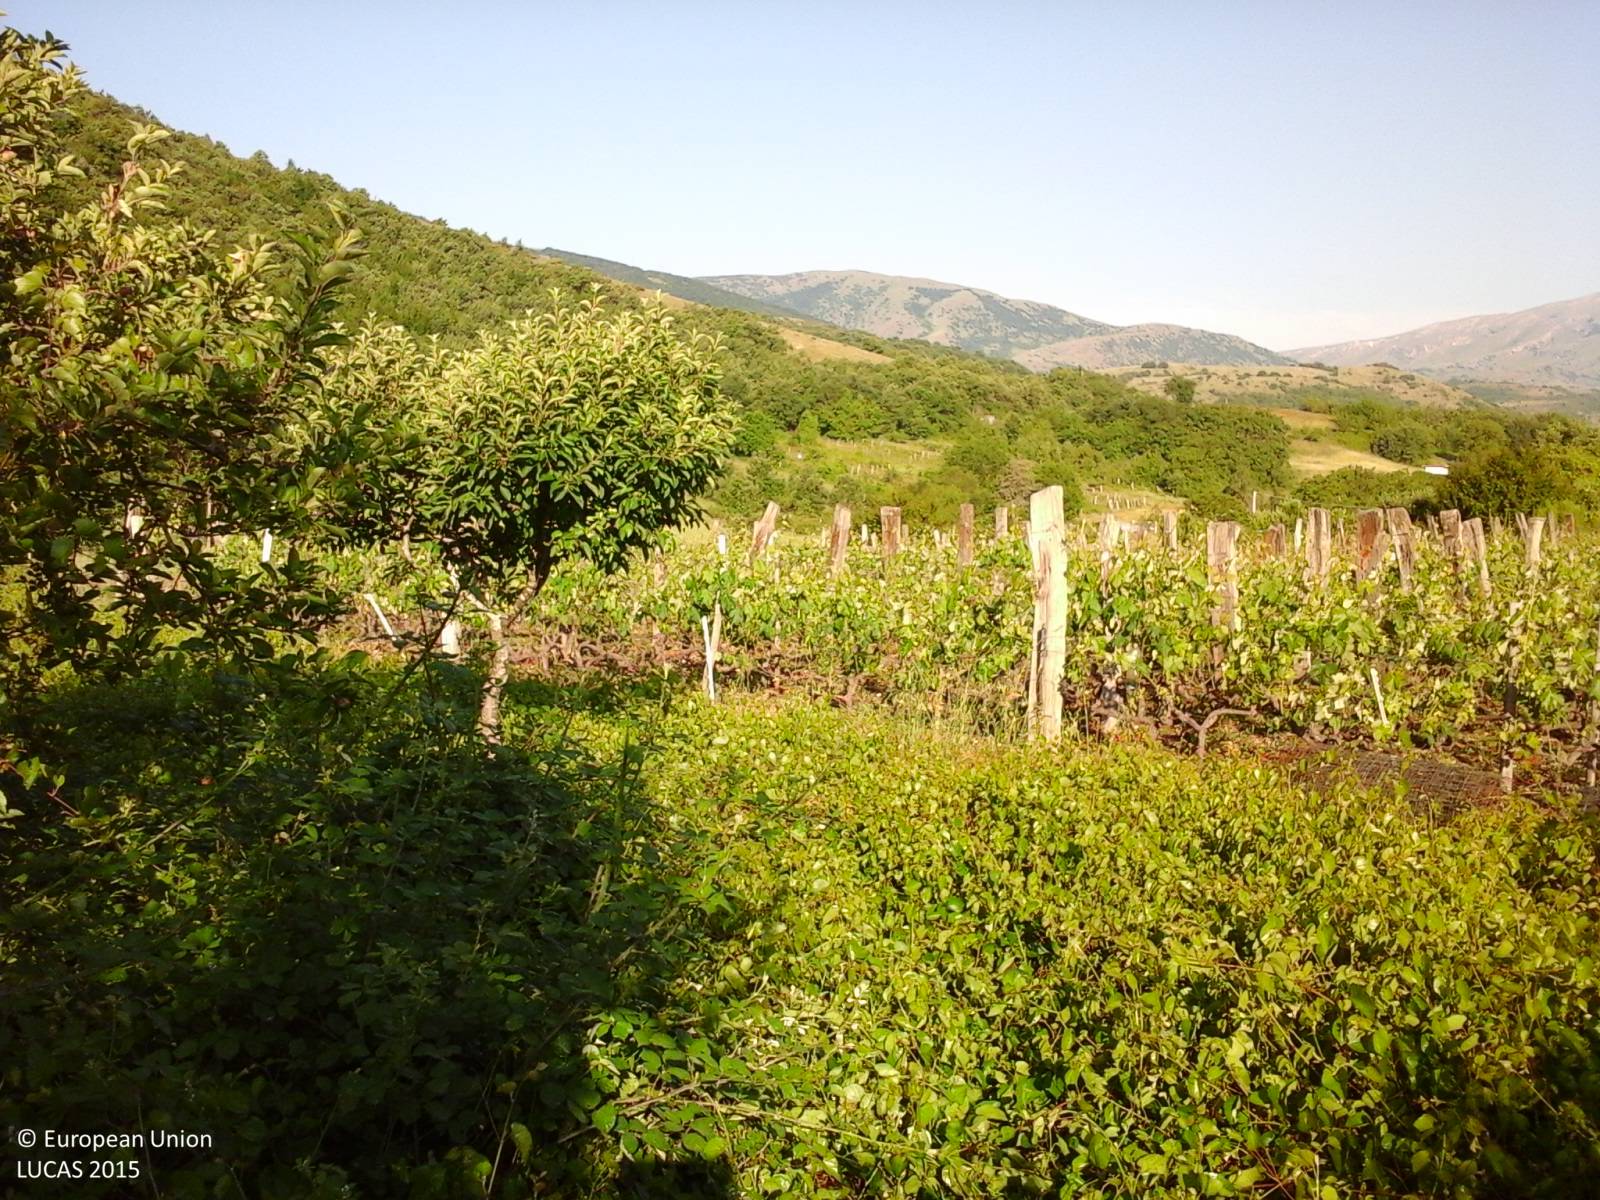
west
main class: Shrubland
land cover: Shrubland with sparse tree cover
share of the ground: > 75 %
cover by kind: shrubs 95 %, broadleaved forest trees 5 %
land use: Abandoned areas
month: June
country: IT
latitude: 42.0775
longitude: 13.7708
